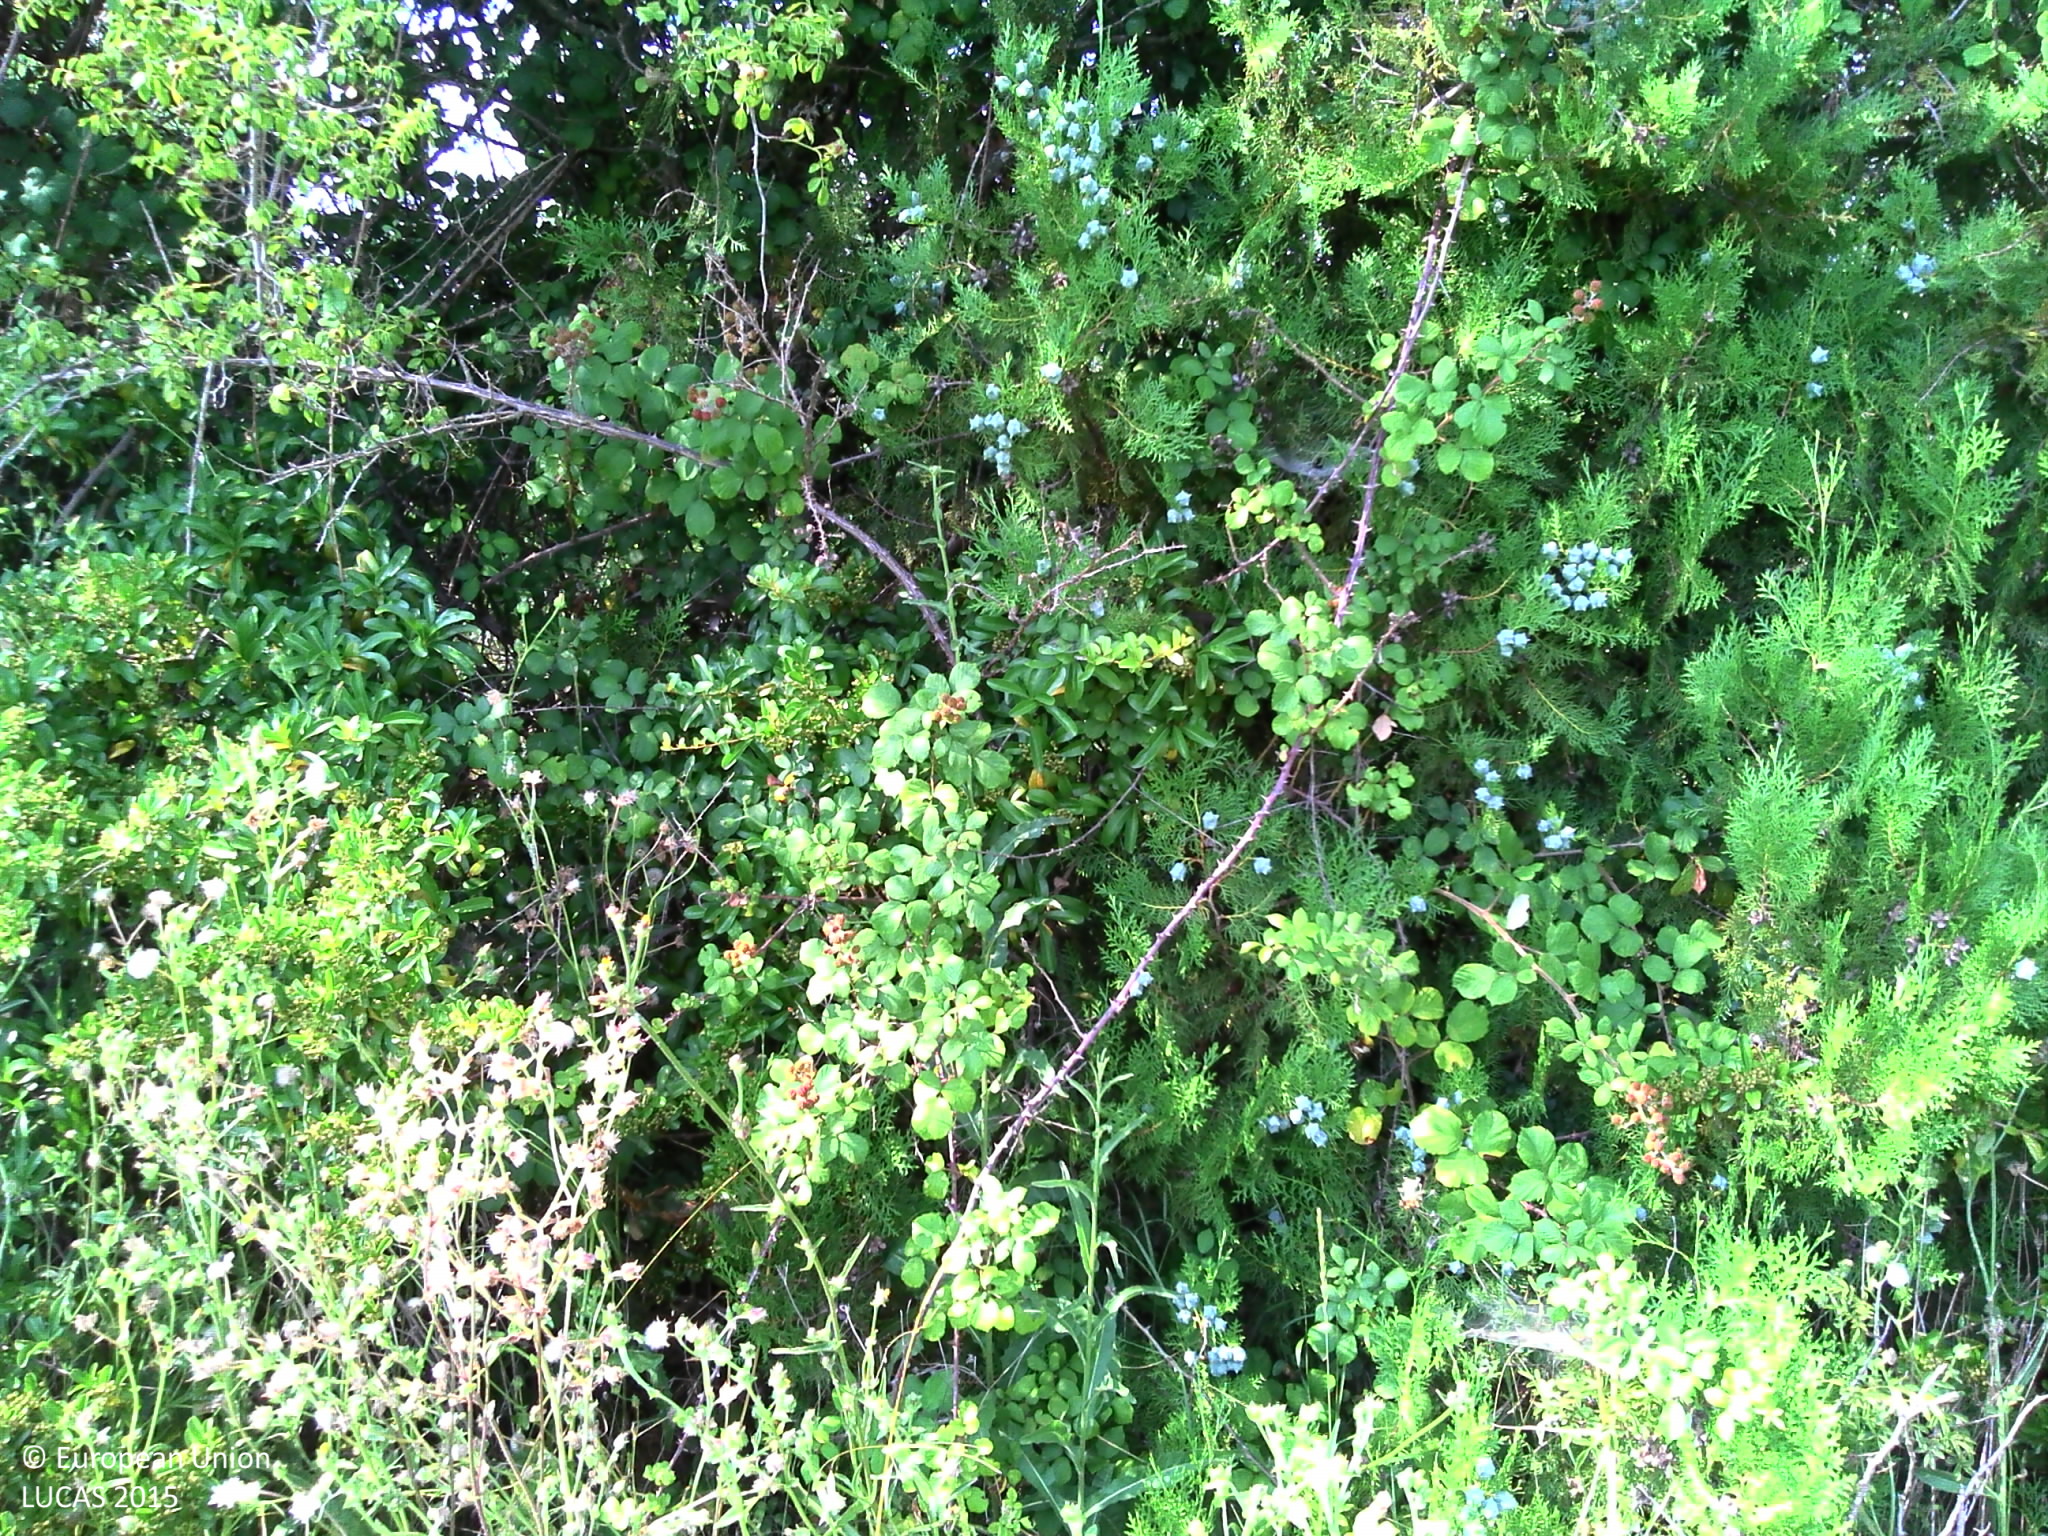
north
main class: Grassland
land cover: Grassland with sparse tree/shrub cover
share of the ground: > 75 %
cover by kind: herbaceous plants 75 %, shrubs 10 %, consolidated bare surface 10 %, broadleaved forest trees 5 %
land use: Residential
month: July
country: FR
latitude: 43.7885
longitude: 5.6221
